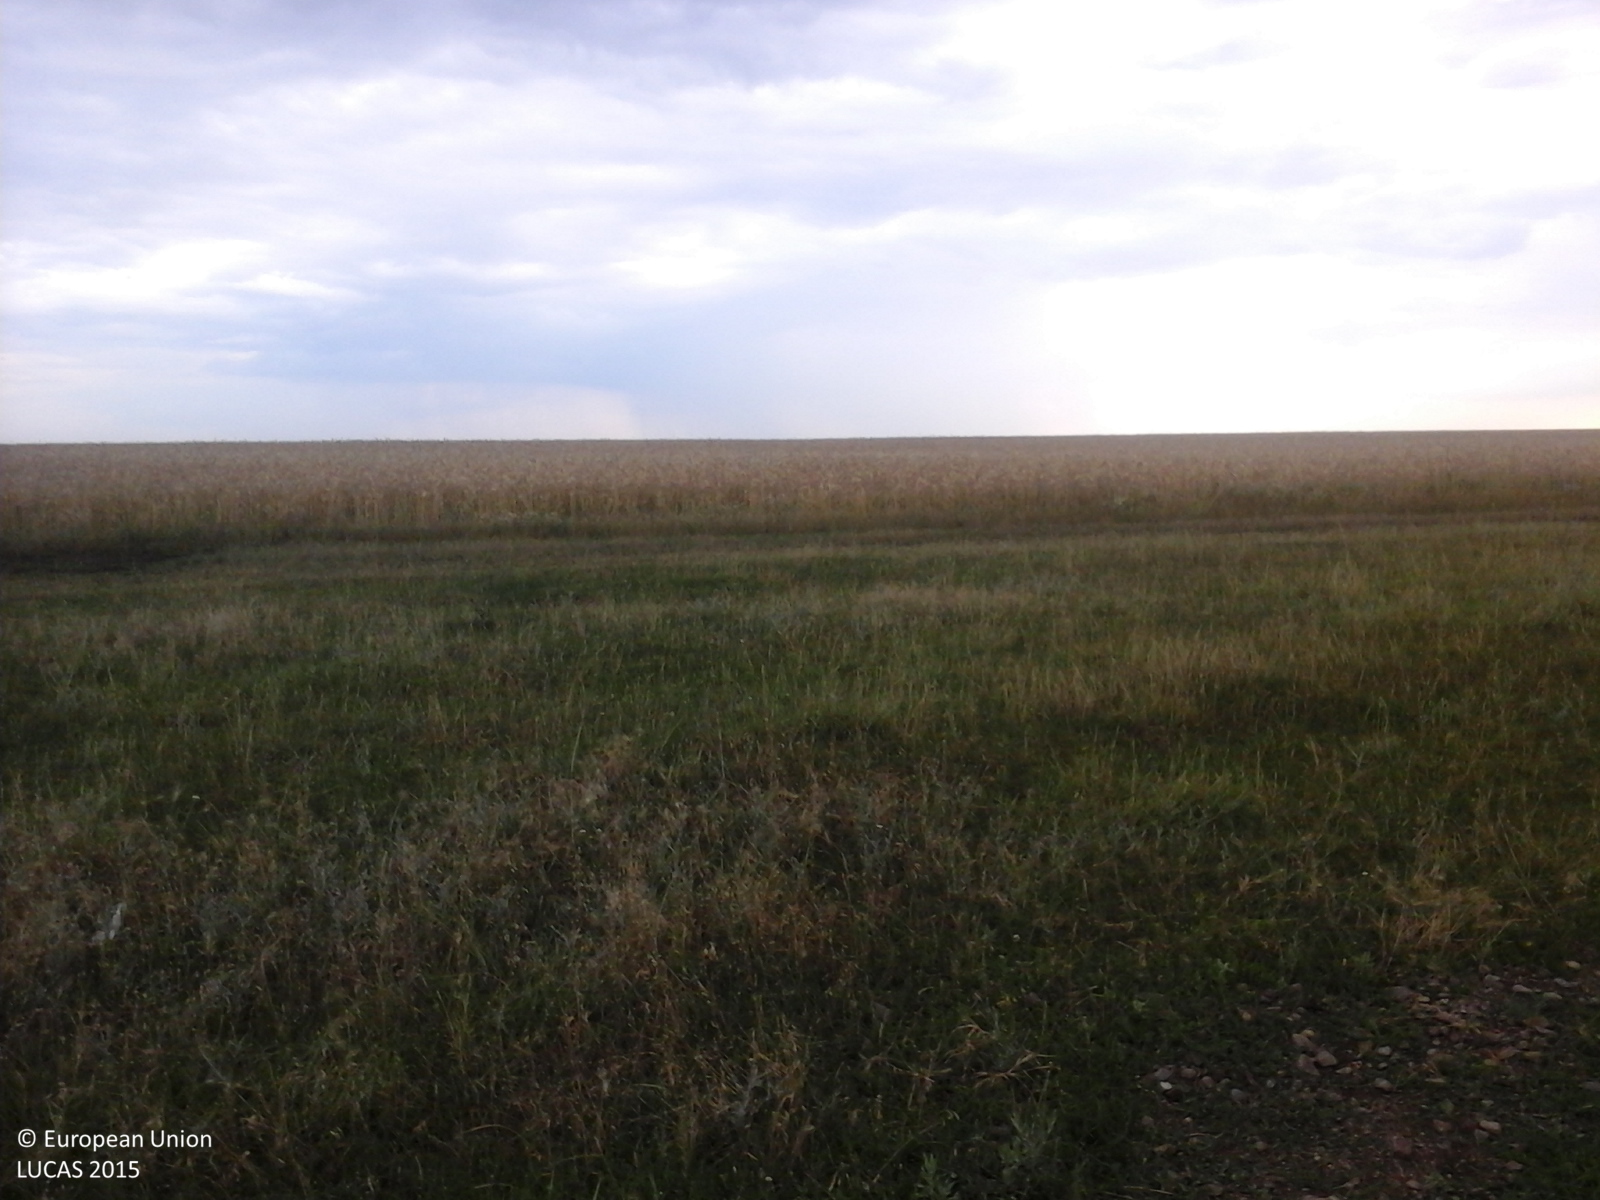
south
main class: Grassland
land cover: Grassland without tree/shrub cover
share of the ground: > 75 %
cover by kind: herbaceous plants 100 %
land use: Agriculture (excluding fallow land and kitchen gardens)
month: July
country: RO
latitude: 44.1094
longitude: 24.9056
